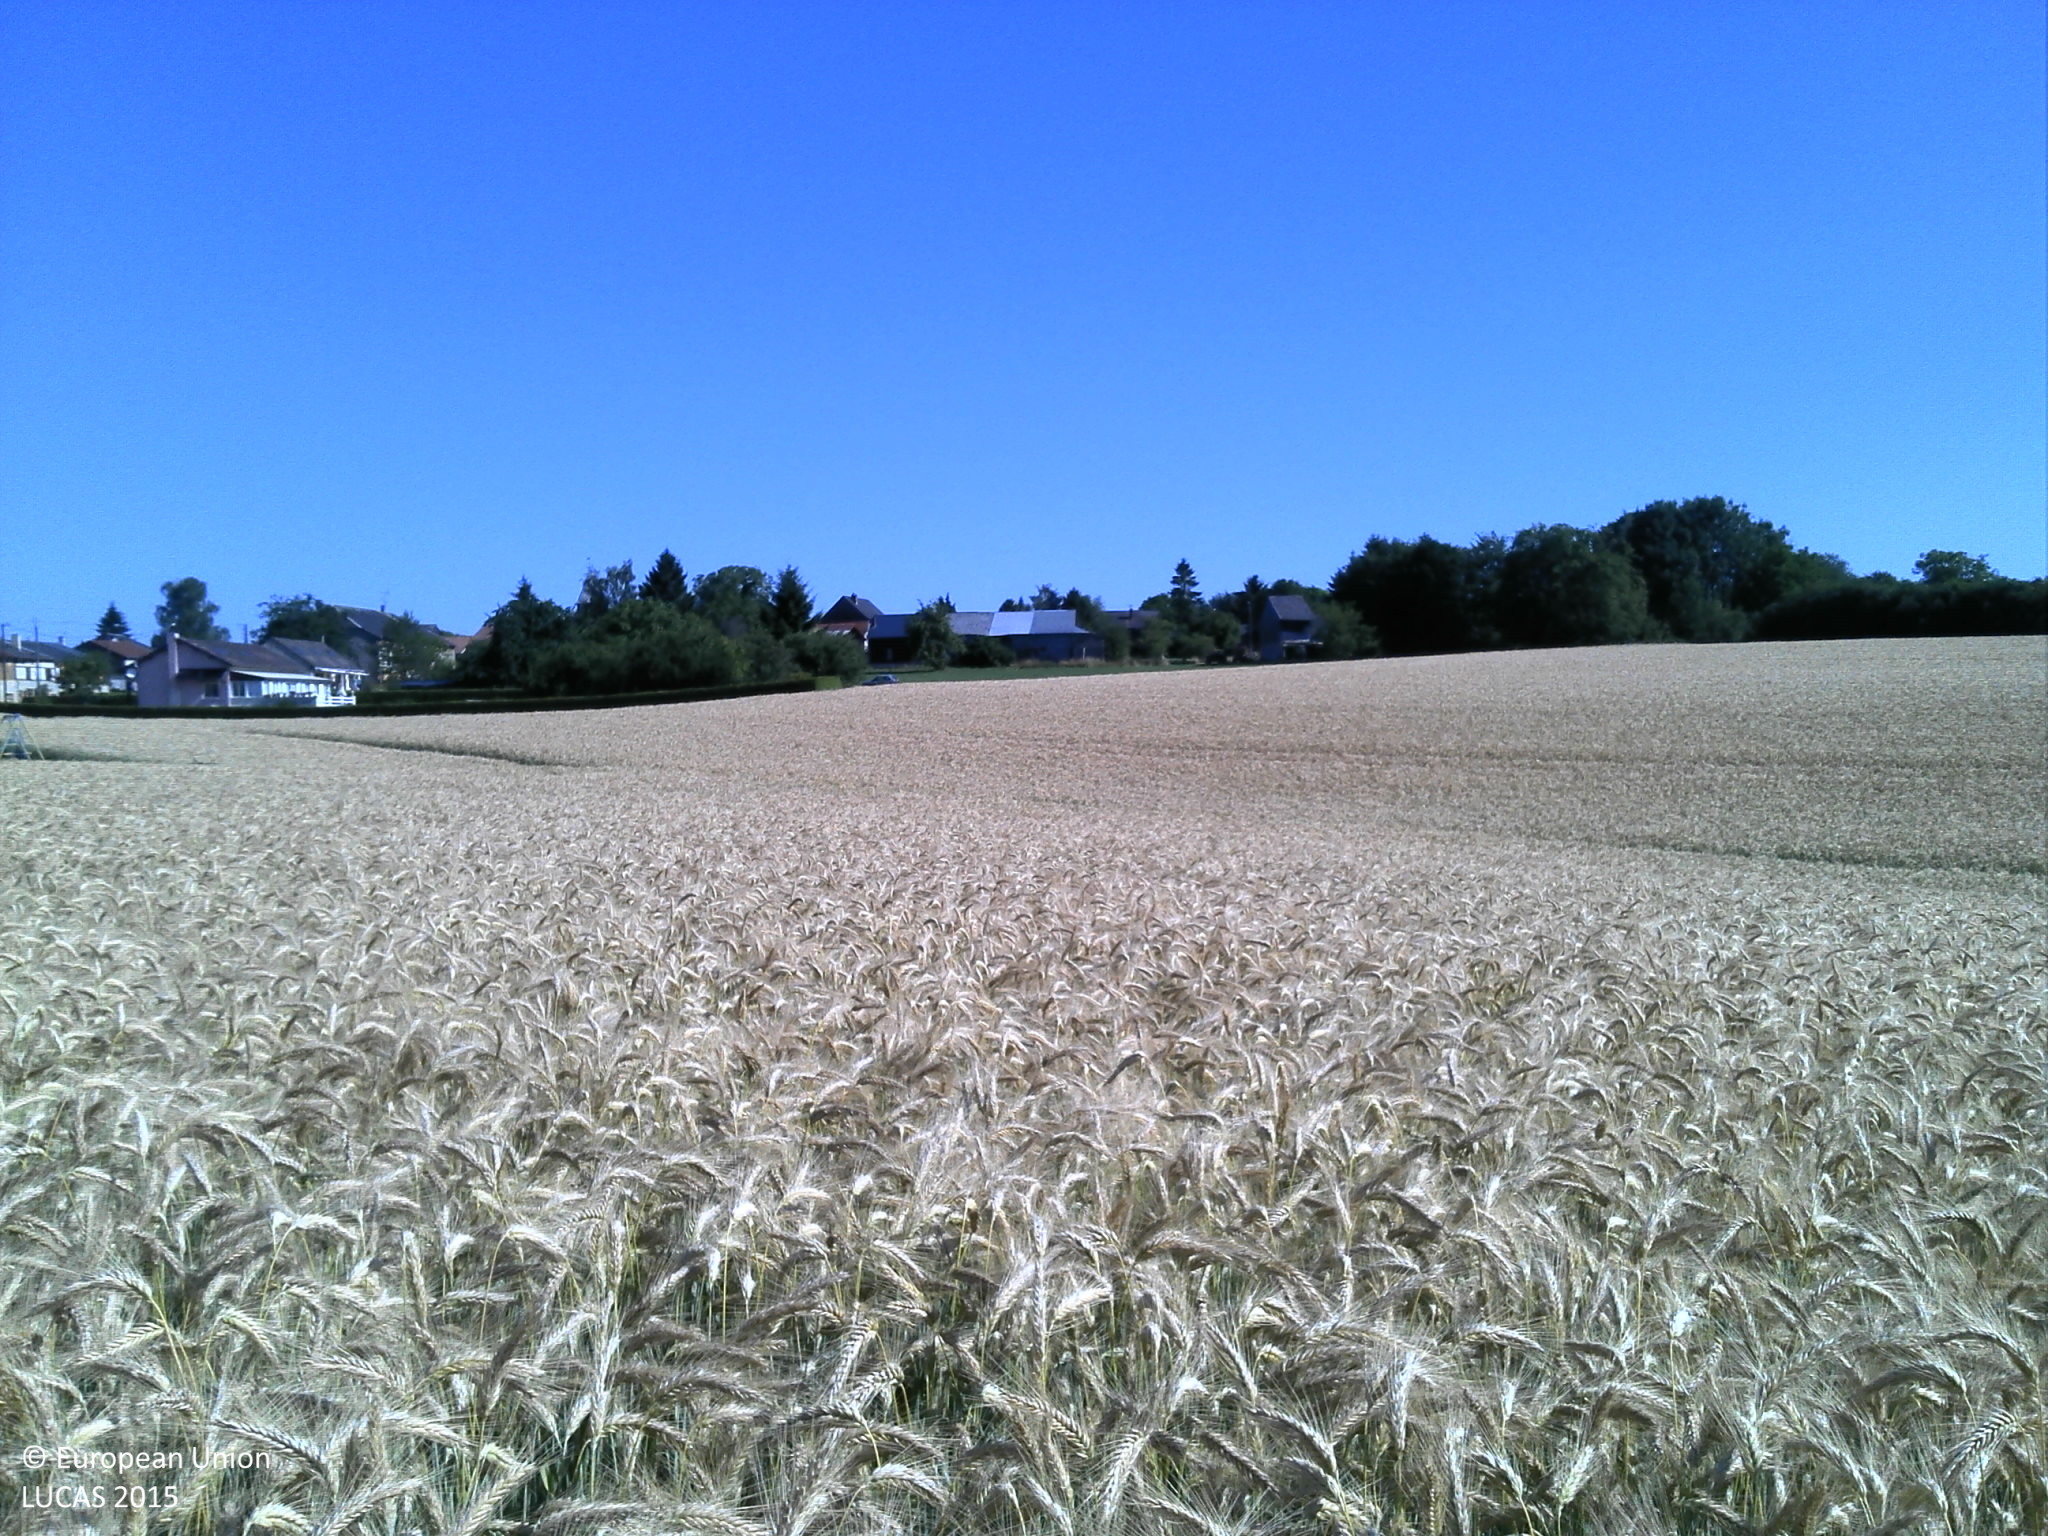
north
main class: Cropland
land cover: Triticale
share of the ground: > 75 %
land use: Agriculture (excluding fallow land and kitchen gardens)
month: July
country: FR
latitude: 49.5911
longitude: 4.6707
